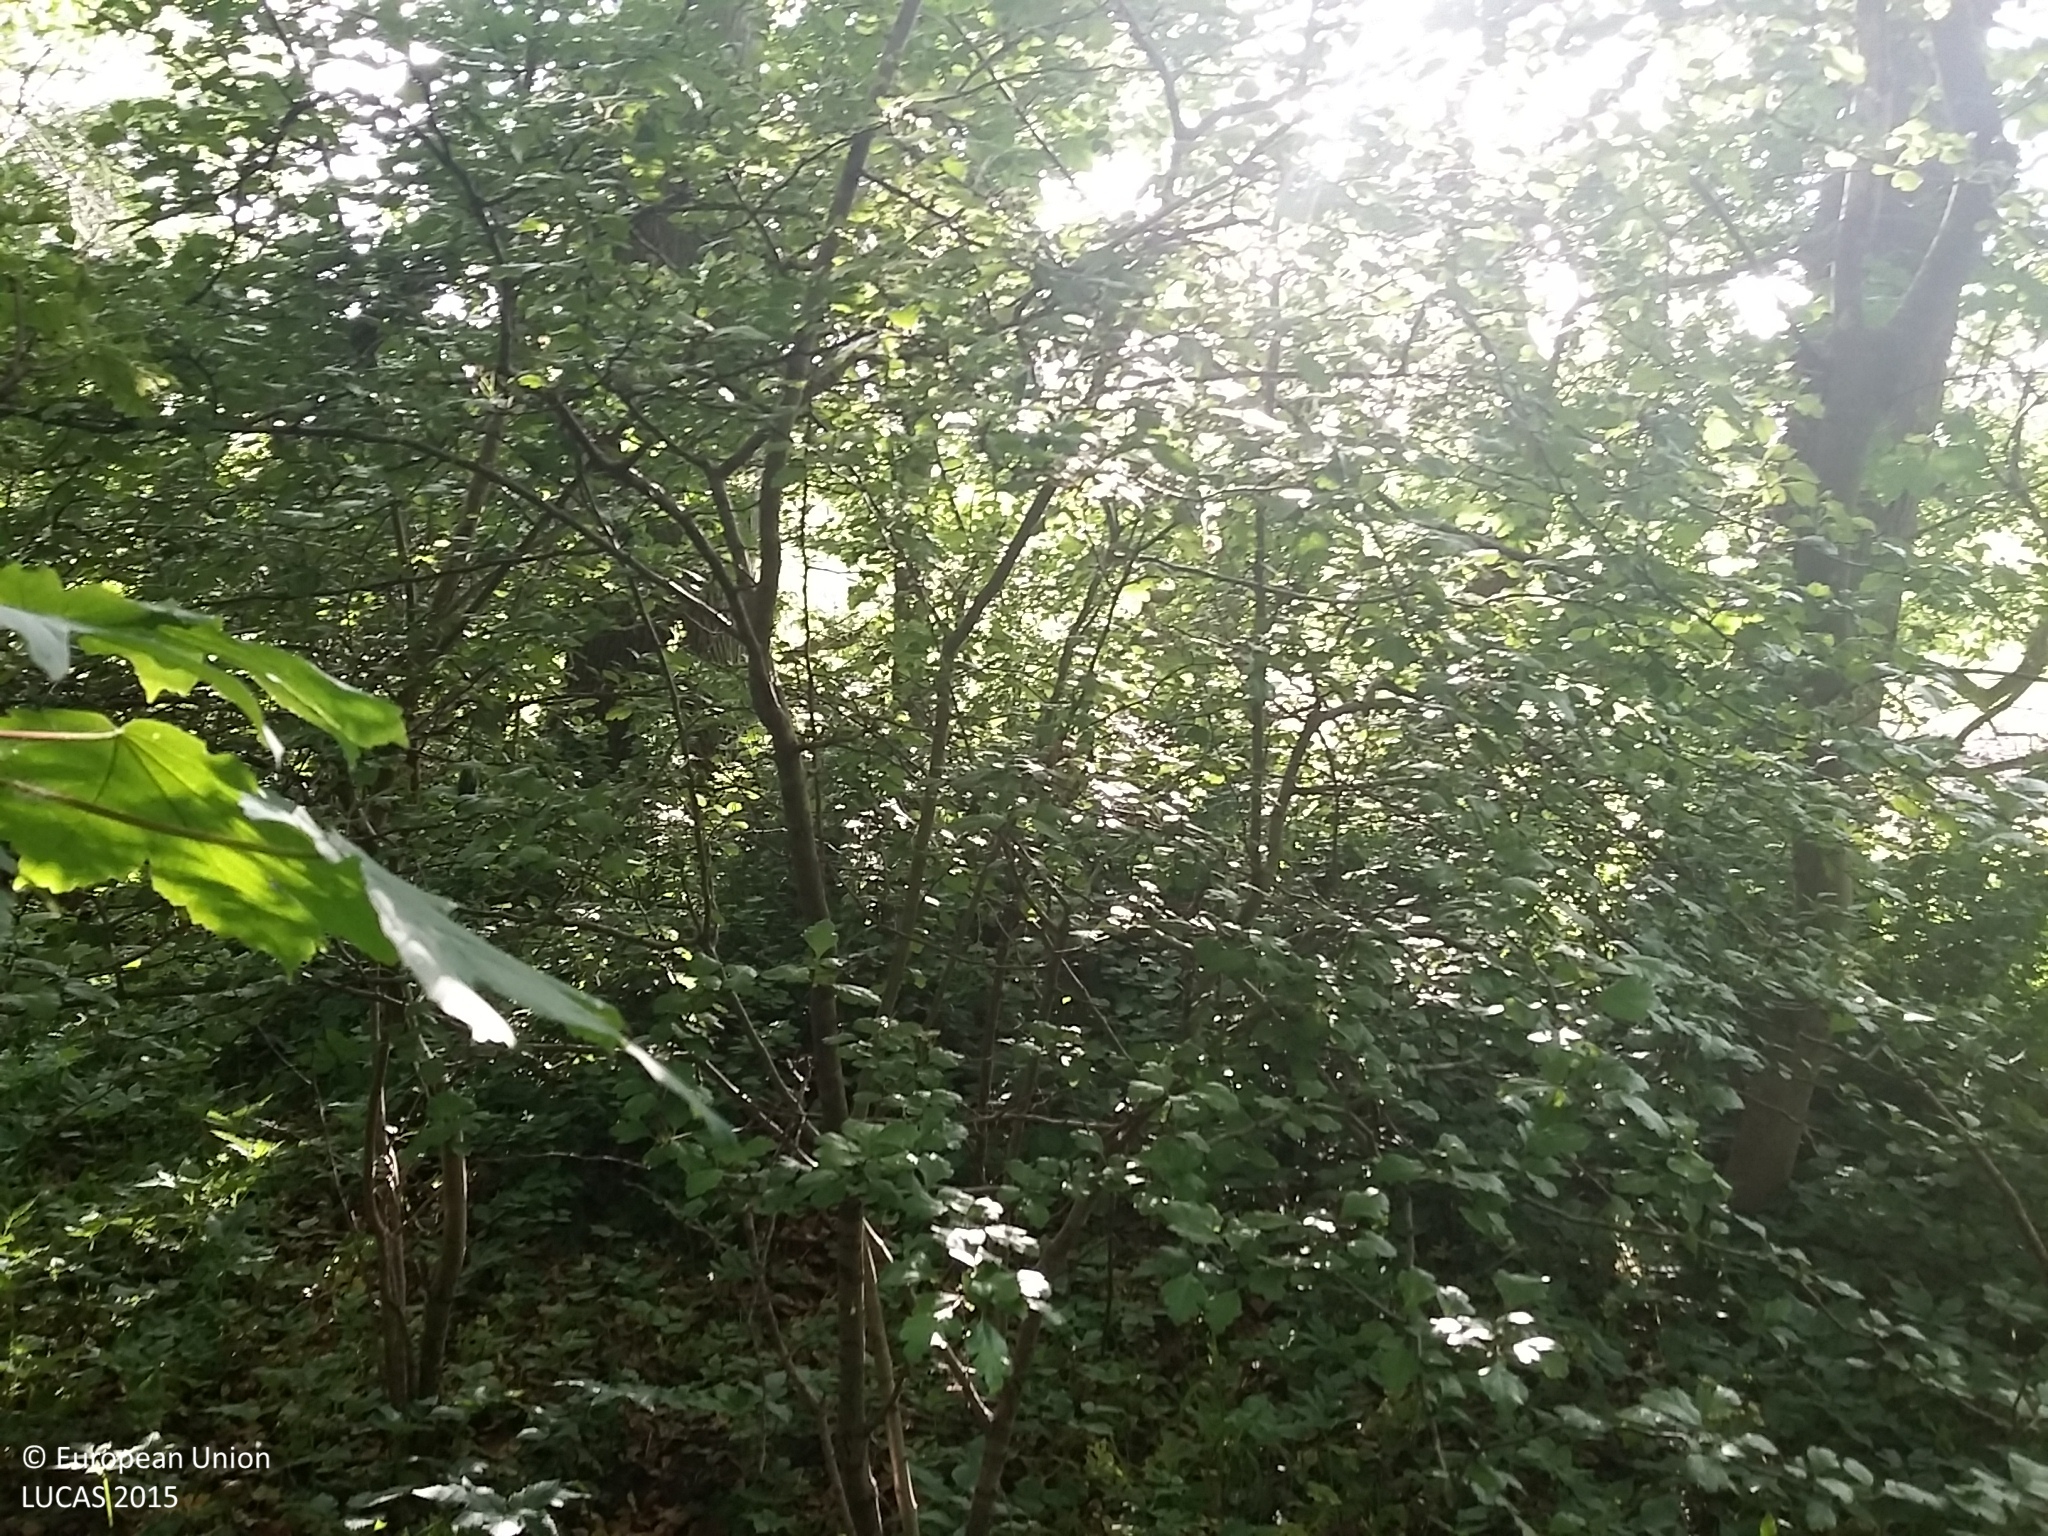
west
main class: Woodland
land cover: Broadleaved woodland
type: beech forest
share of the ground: > 75 %
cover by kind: broadleaved forest trees 85 %, herbaceous plants 15 %
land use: Forestry
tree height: > 5 m
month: June
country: DK
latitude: 55.3774
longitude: 10.6149
